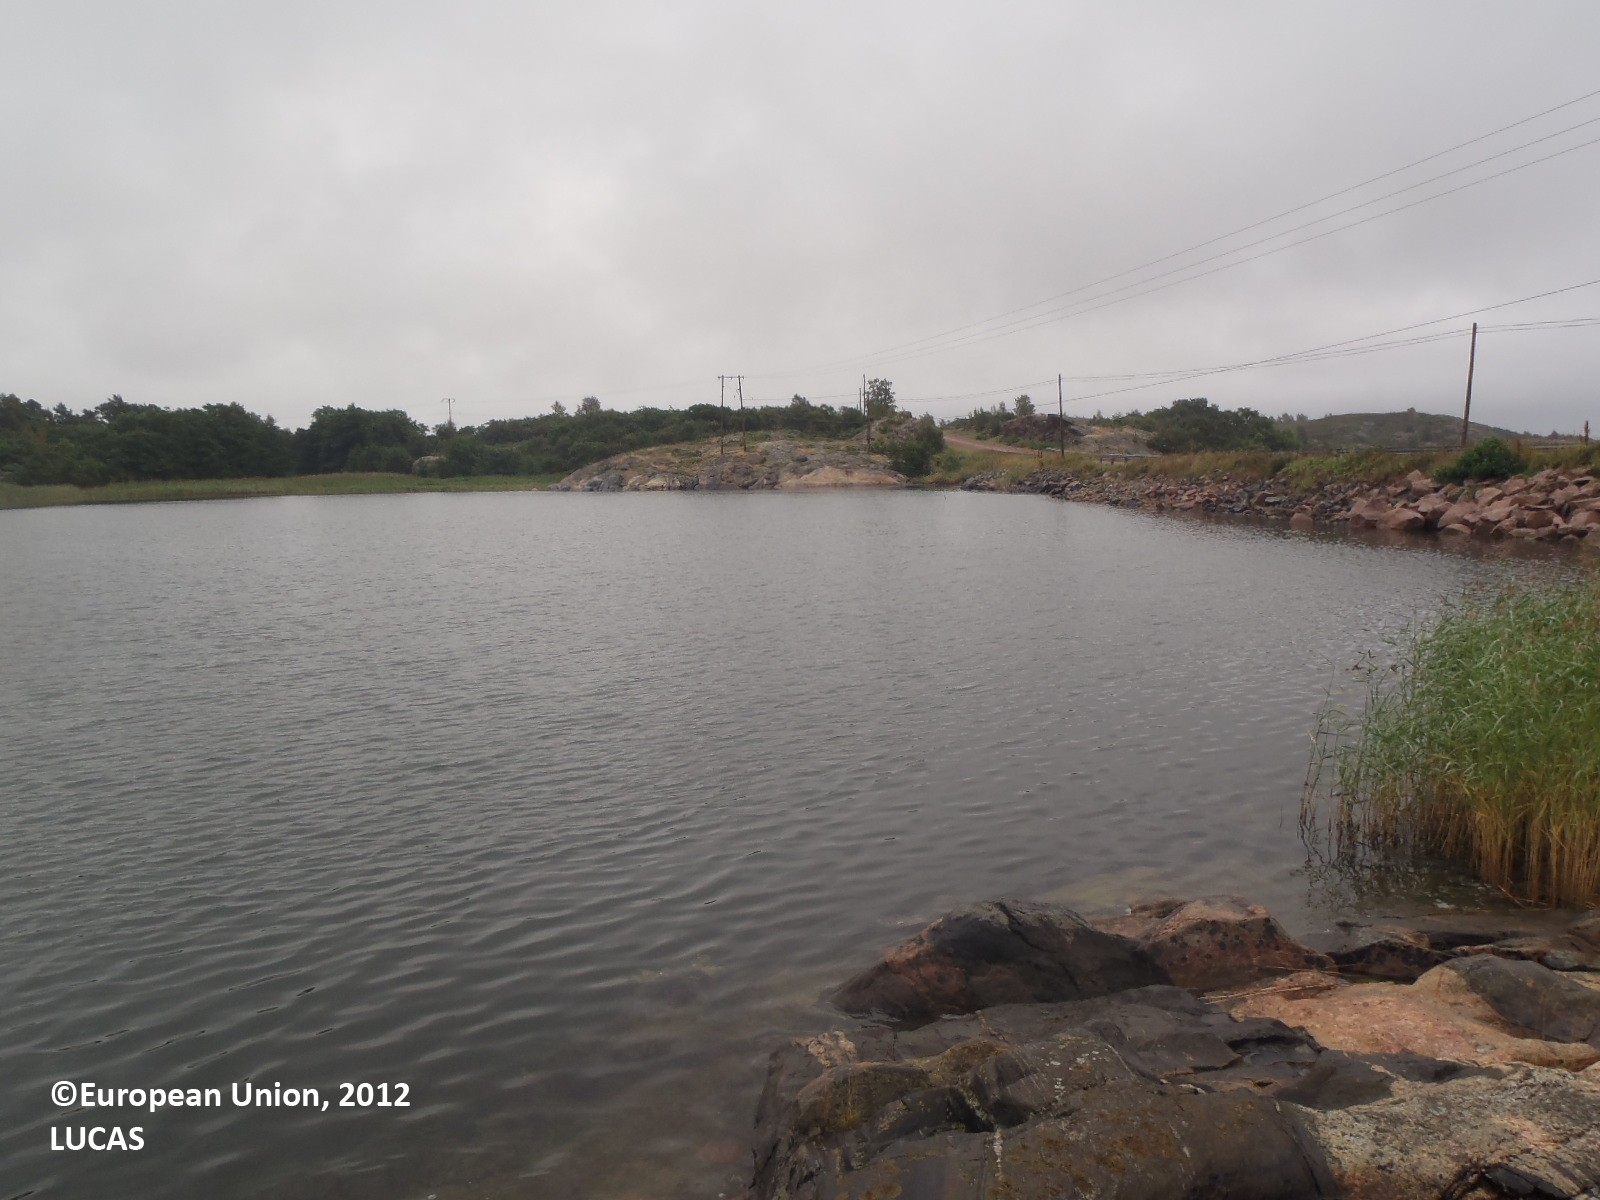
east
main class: Grassland
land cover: Grassland with sparse tree/shrub cover
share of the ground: > 75 %
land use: Semi-natural and natural areas not in use
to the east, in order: Grassland with sparse tree/shrub cover; Rocks and stones; Transitional water bodies; Rocks and stones; Grassland without tree/shrub cover; Rocks and stones; Lichens and moss; Shrubland without tree cover; Rocks and stones; Shrubland without tree cover
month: August
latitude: 60.4252
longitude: 20.9674
